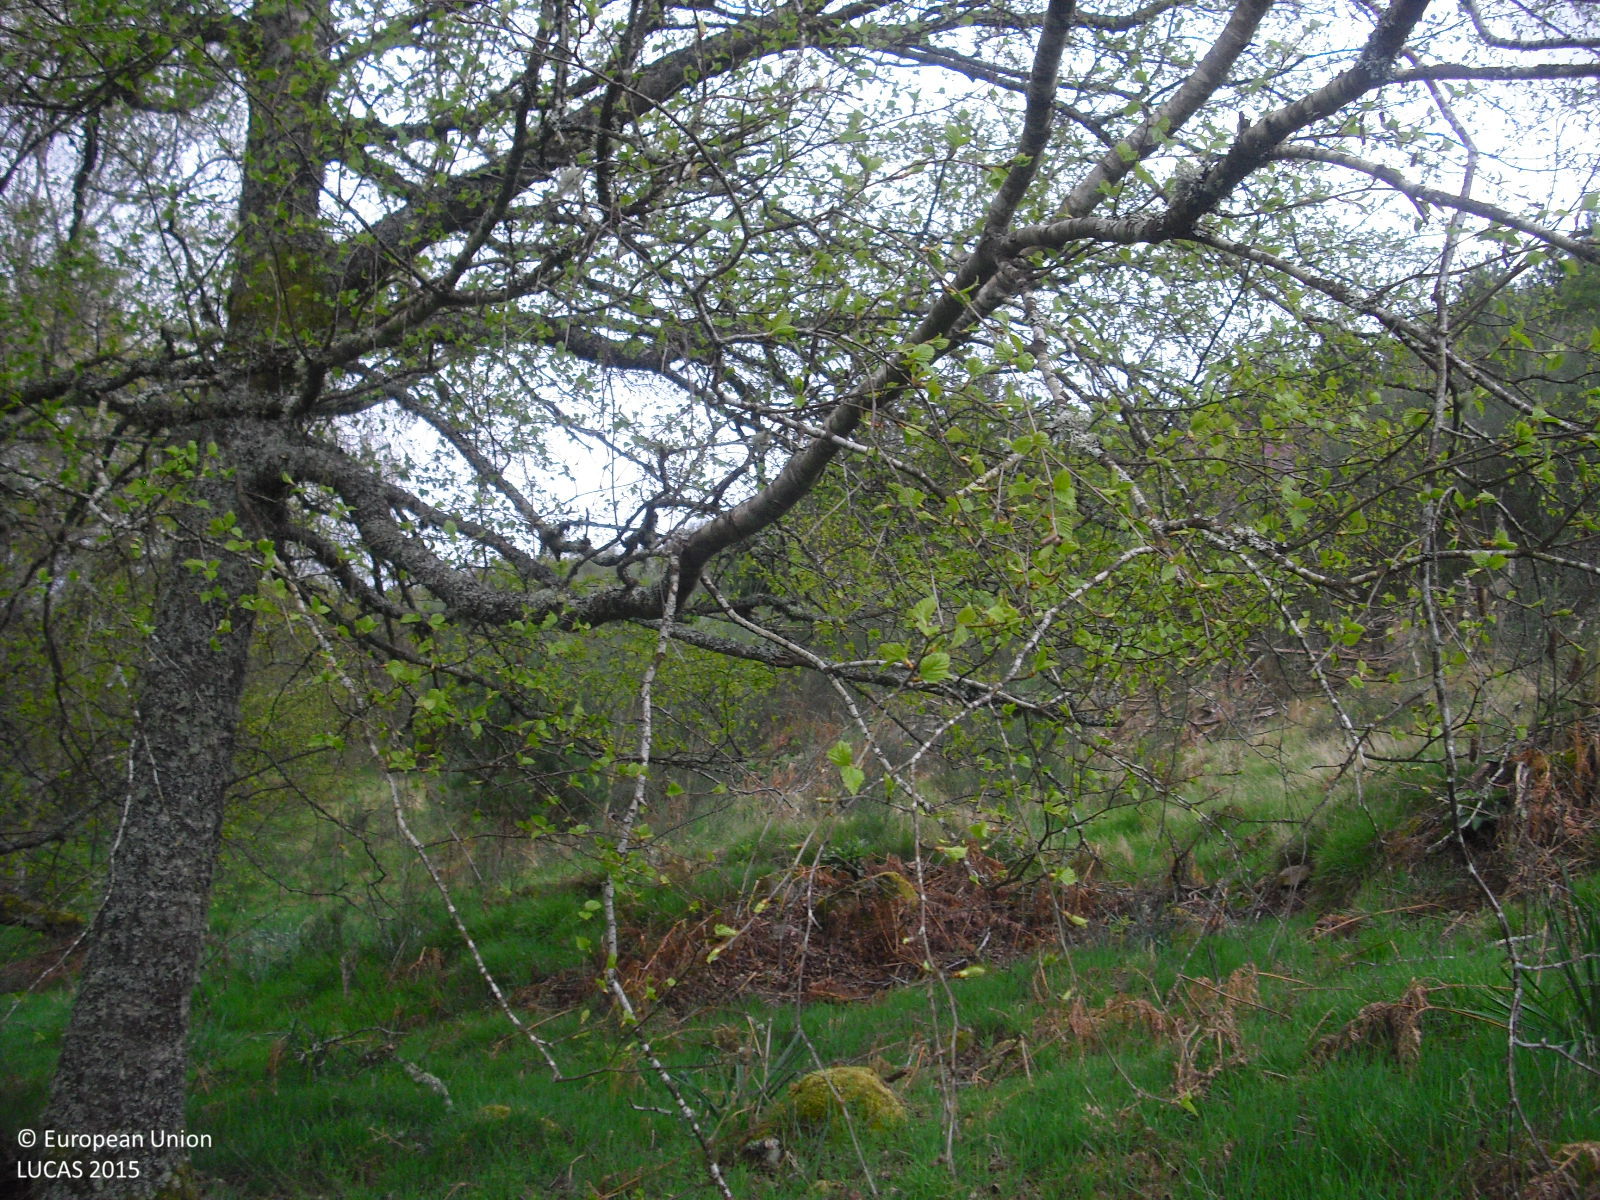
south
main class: Woodland
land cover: Broadleaved woodland
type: beech forest
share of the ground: 25 - 50 %
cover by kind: herbaceous plants 50 %, broadleaved forest trees 30 %, shrubs 20 %
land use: Forestry
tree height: > 5 m
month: April
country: ES
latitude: 41.9139
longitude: -7.6807
